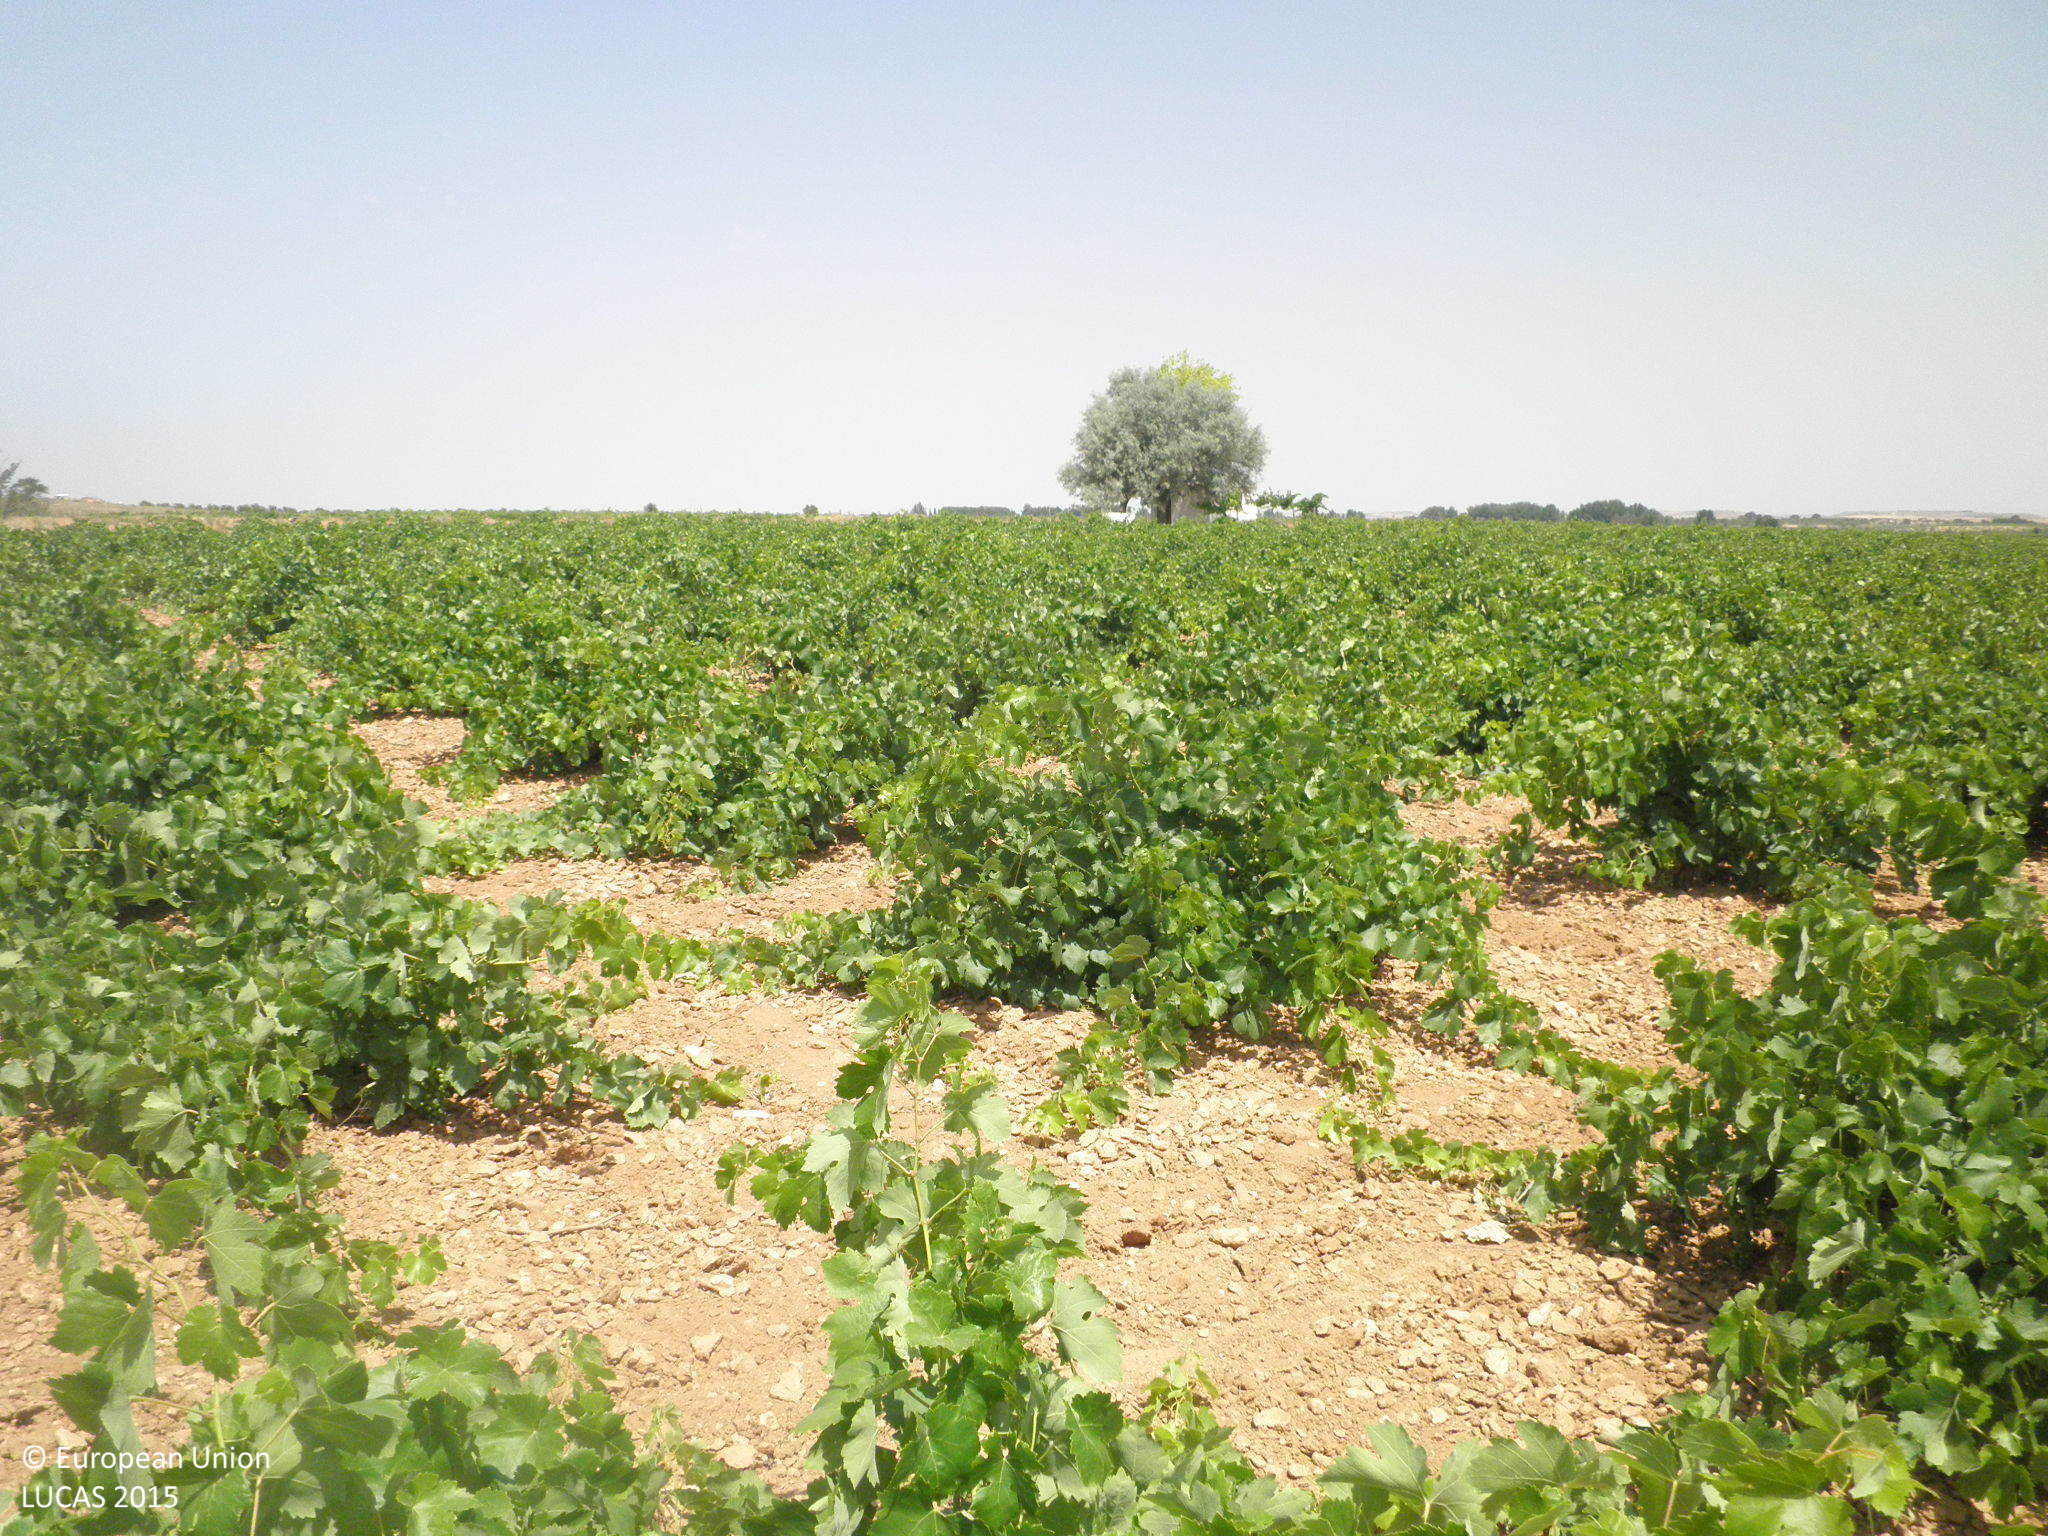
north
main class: Cropland
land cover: Vineyards
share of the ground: 25 - 50 %
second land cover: Other bare soil
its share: > 75 %
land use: Agriculture (excluding fallow land and kitchen gardens)
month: July
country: ES
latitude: 39.4990
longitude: -2.7950
